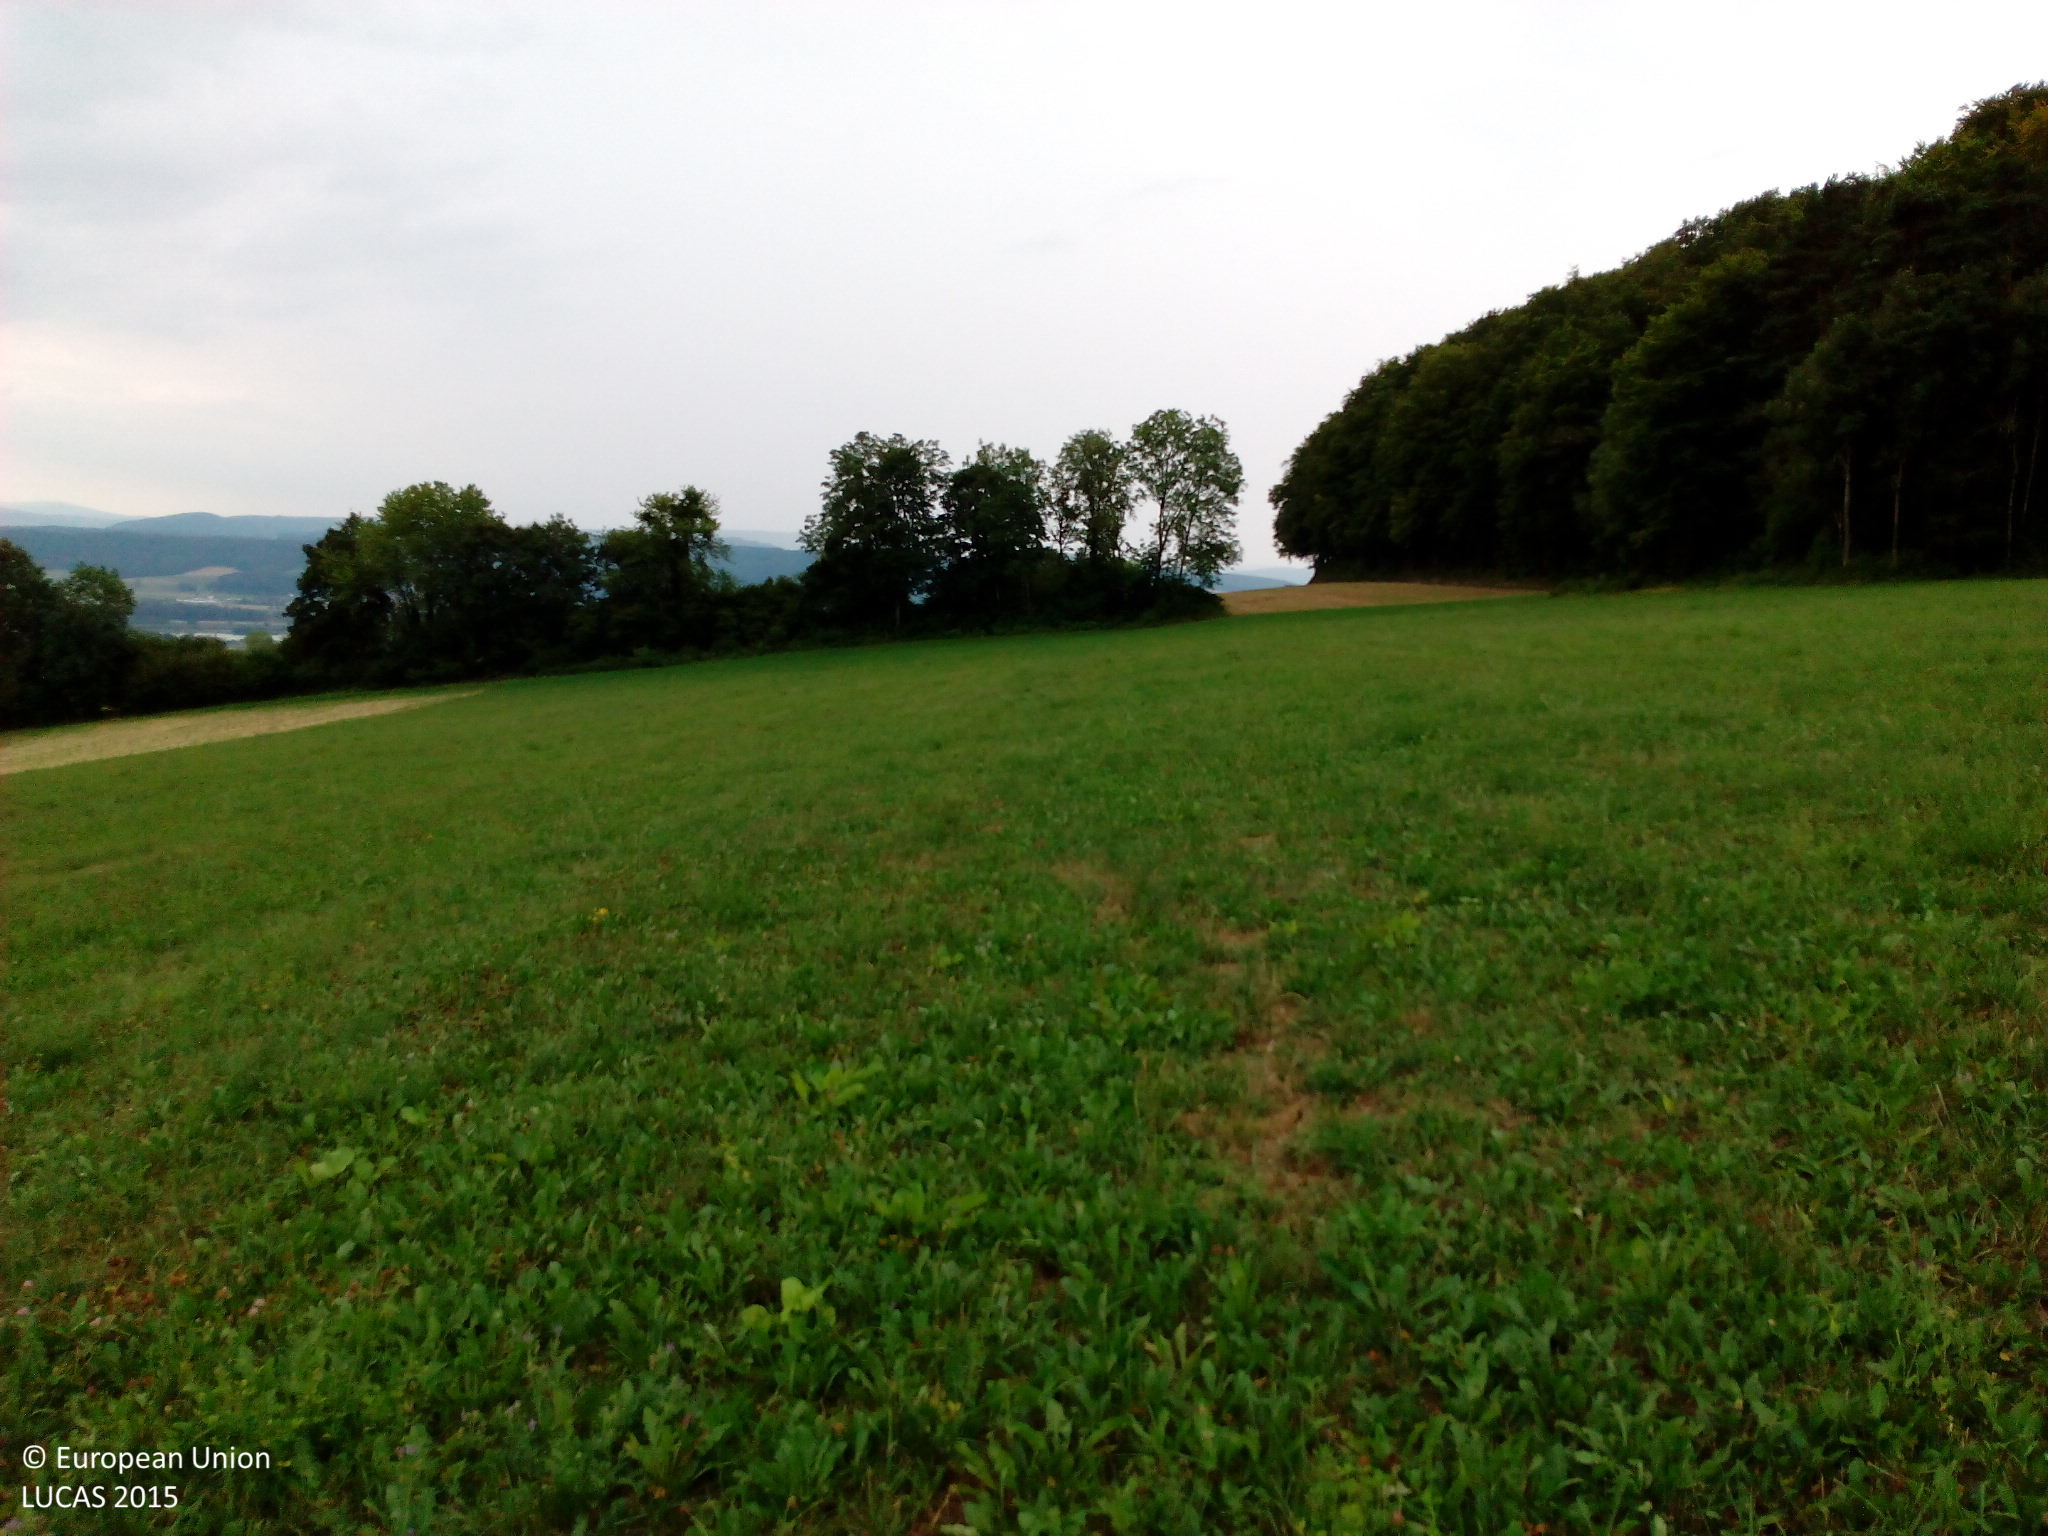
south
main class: Grassland
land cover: Grassland without tree/shrub cover
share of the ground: > 75 %
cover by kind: herbaceous plants 95 %, unconsolidated bare surface 5 %
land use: Agriculture (excluding fallow land and kitchen gardens)
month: August
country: DE
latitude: 47.6320
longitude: 8.1514
